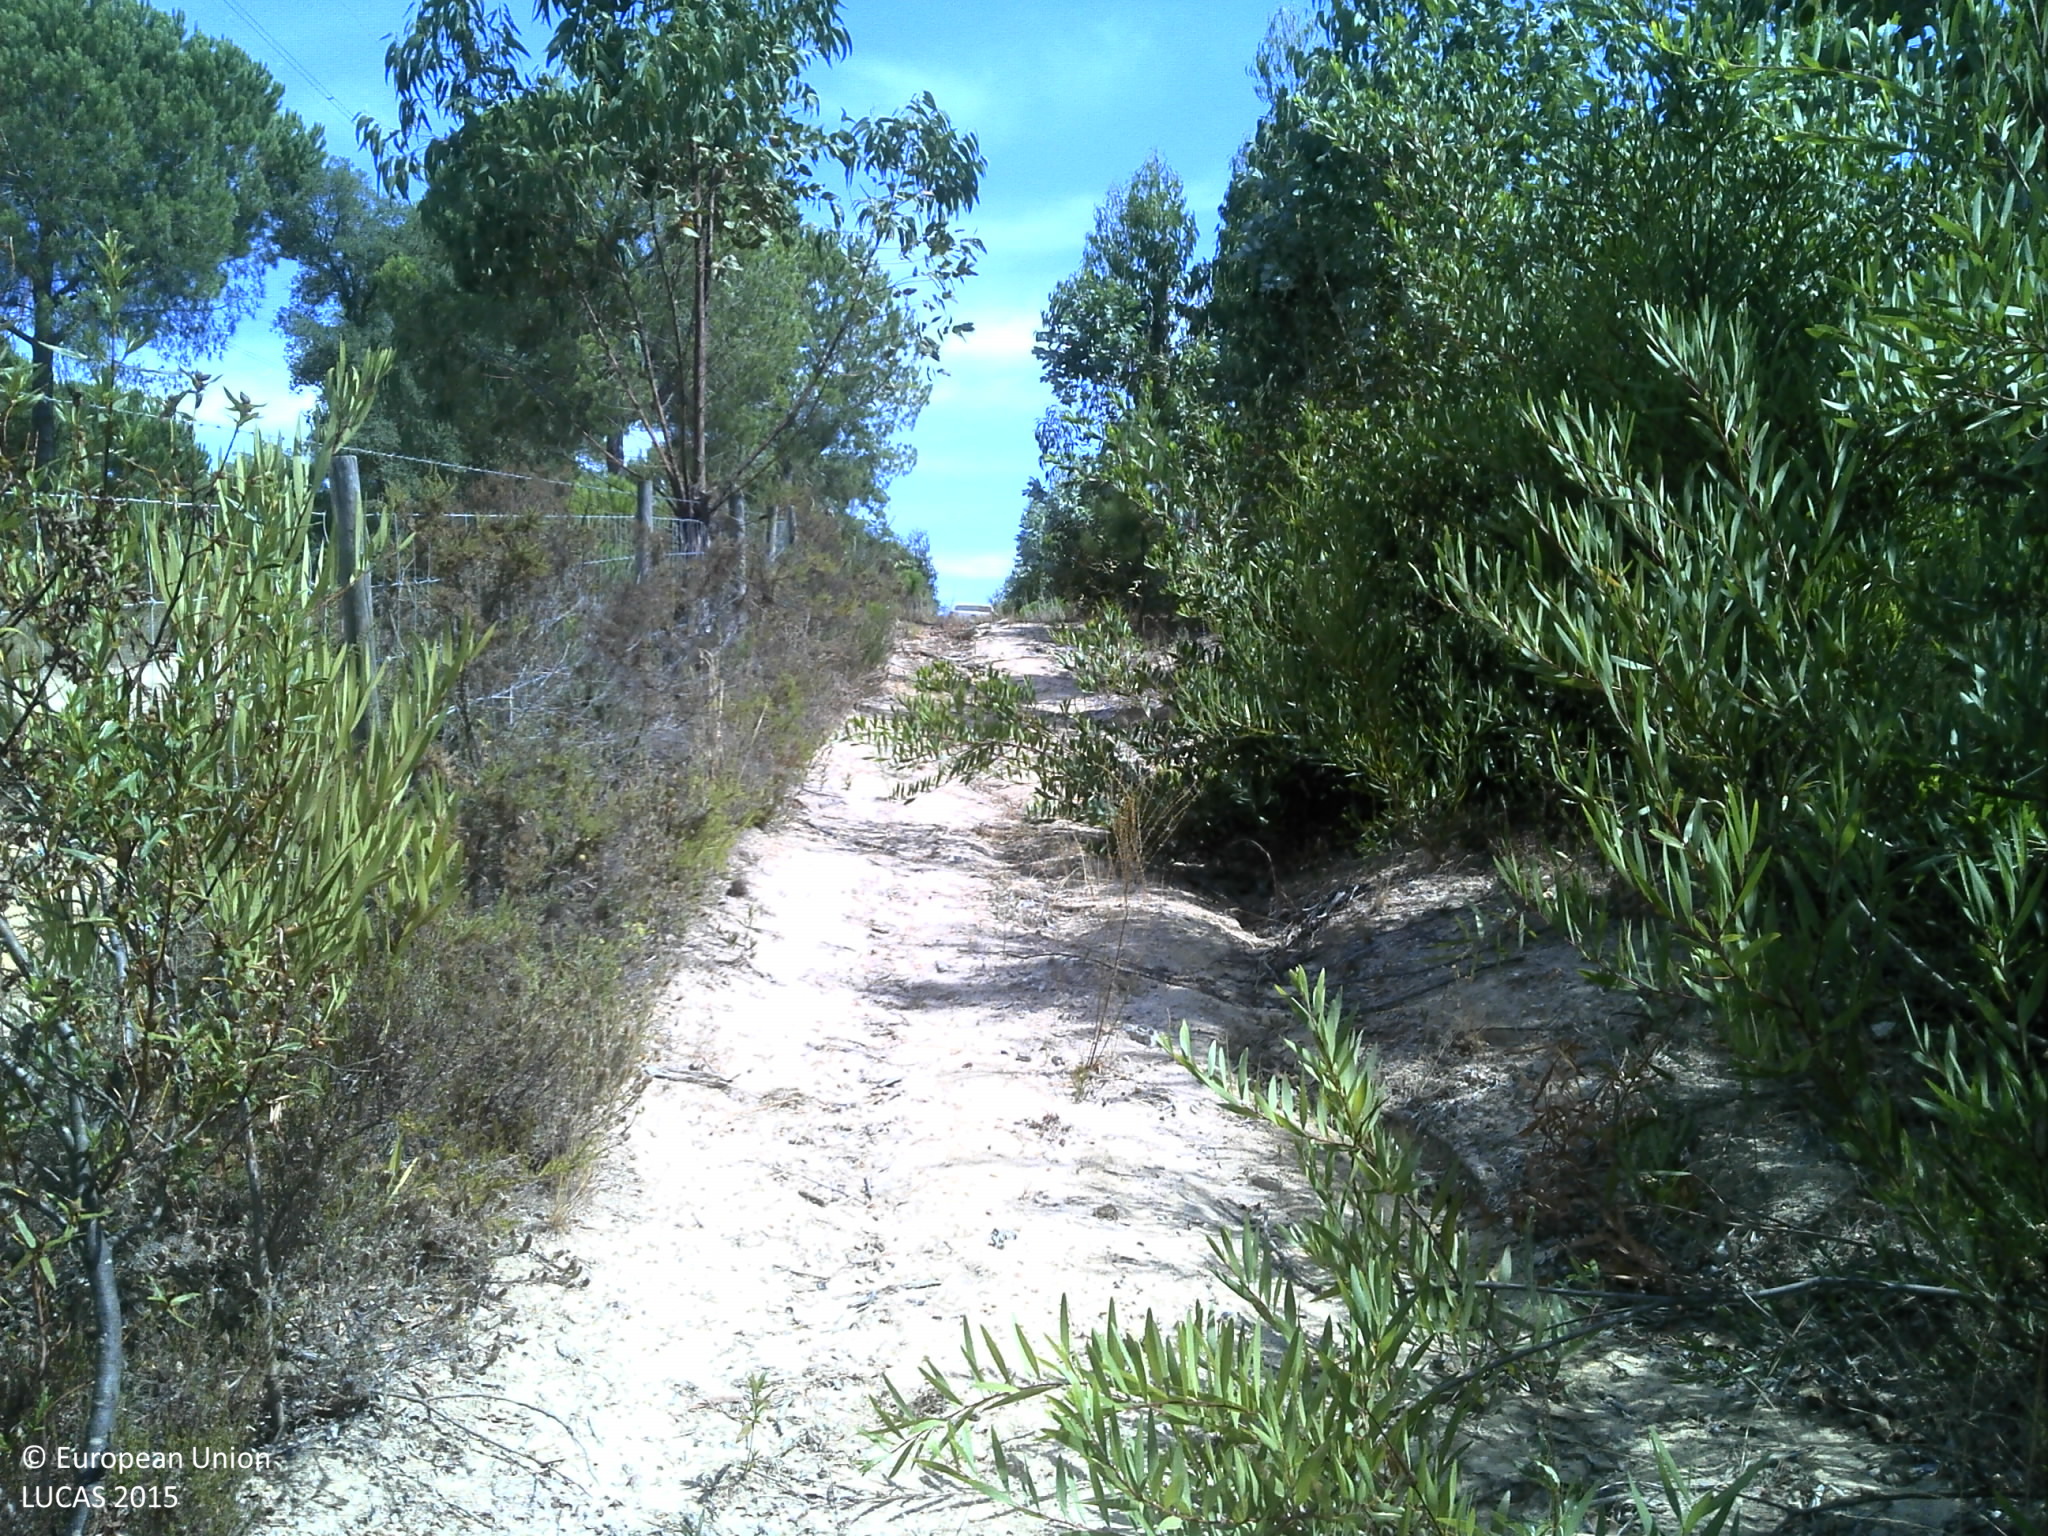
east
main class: Woodland
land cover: Pine dominated mixed woodland
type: coniferous forest of the mediterranean region
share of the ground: 25 - 50 %
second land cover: Shrubland without tree cover
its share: 10 - 25 %
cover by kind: unconsolidated bare surface 35 %, coniferous forest trees 30 %, broadleaved forest trees 20 %, shrubs 15 %
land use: Forestry
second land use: Agriculture (excluding fallow land and kitchen gardens)
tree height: > 5 m
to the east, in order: Pine dominated mixed woodland; Shrubland without tree cover; Rivers and streams; Shrubland without tree cover; Broadleaved woodland
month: August
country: PT
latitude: 38.7316
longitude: -8.5920
